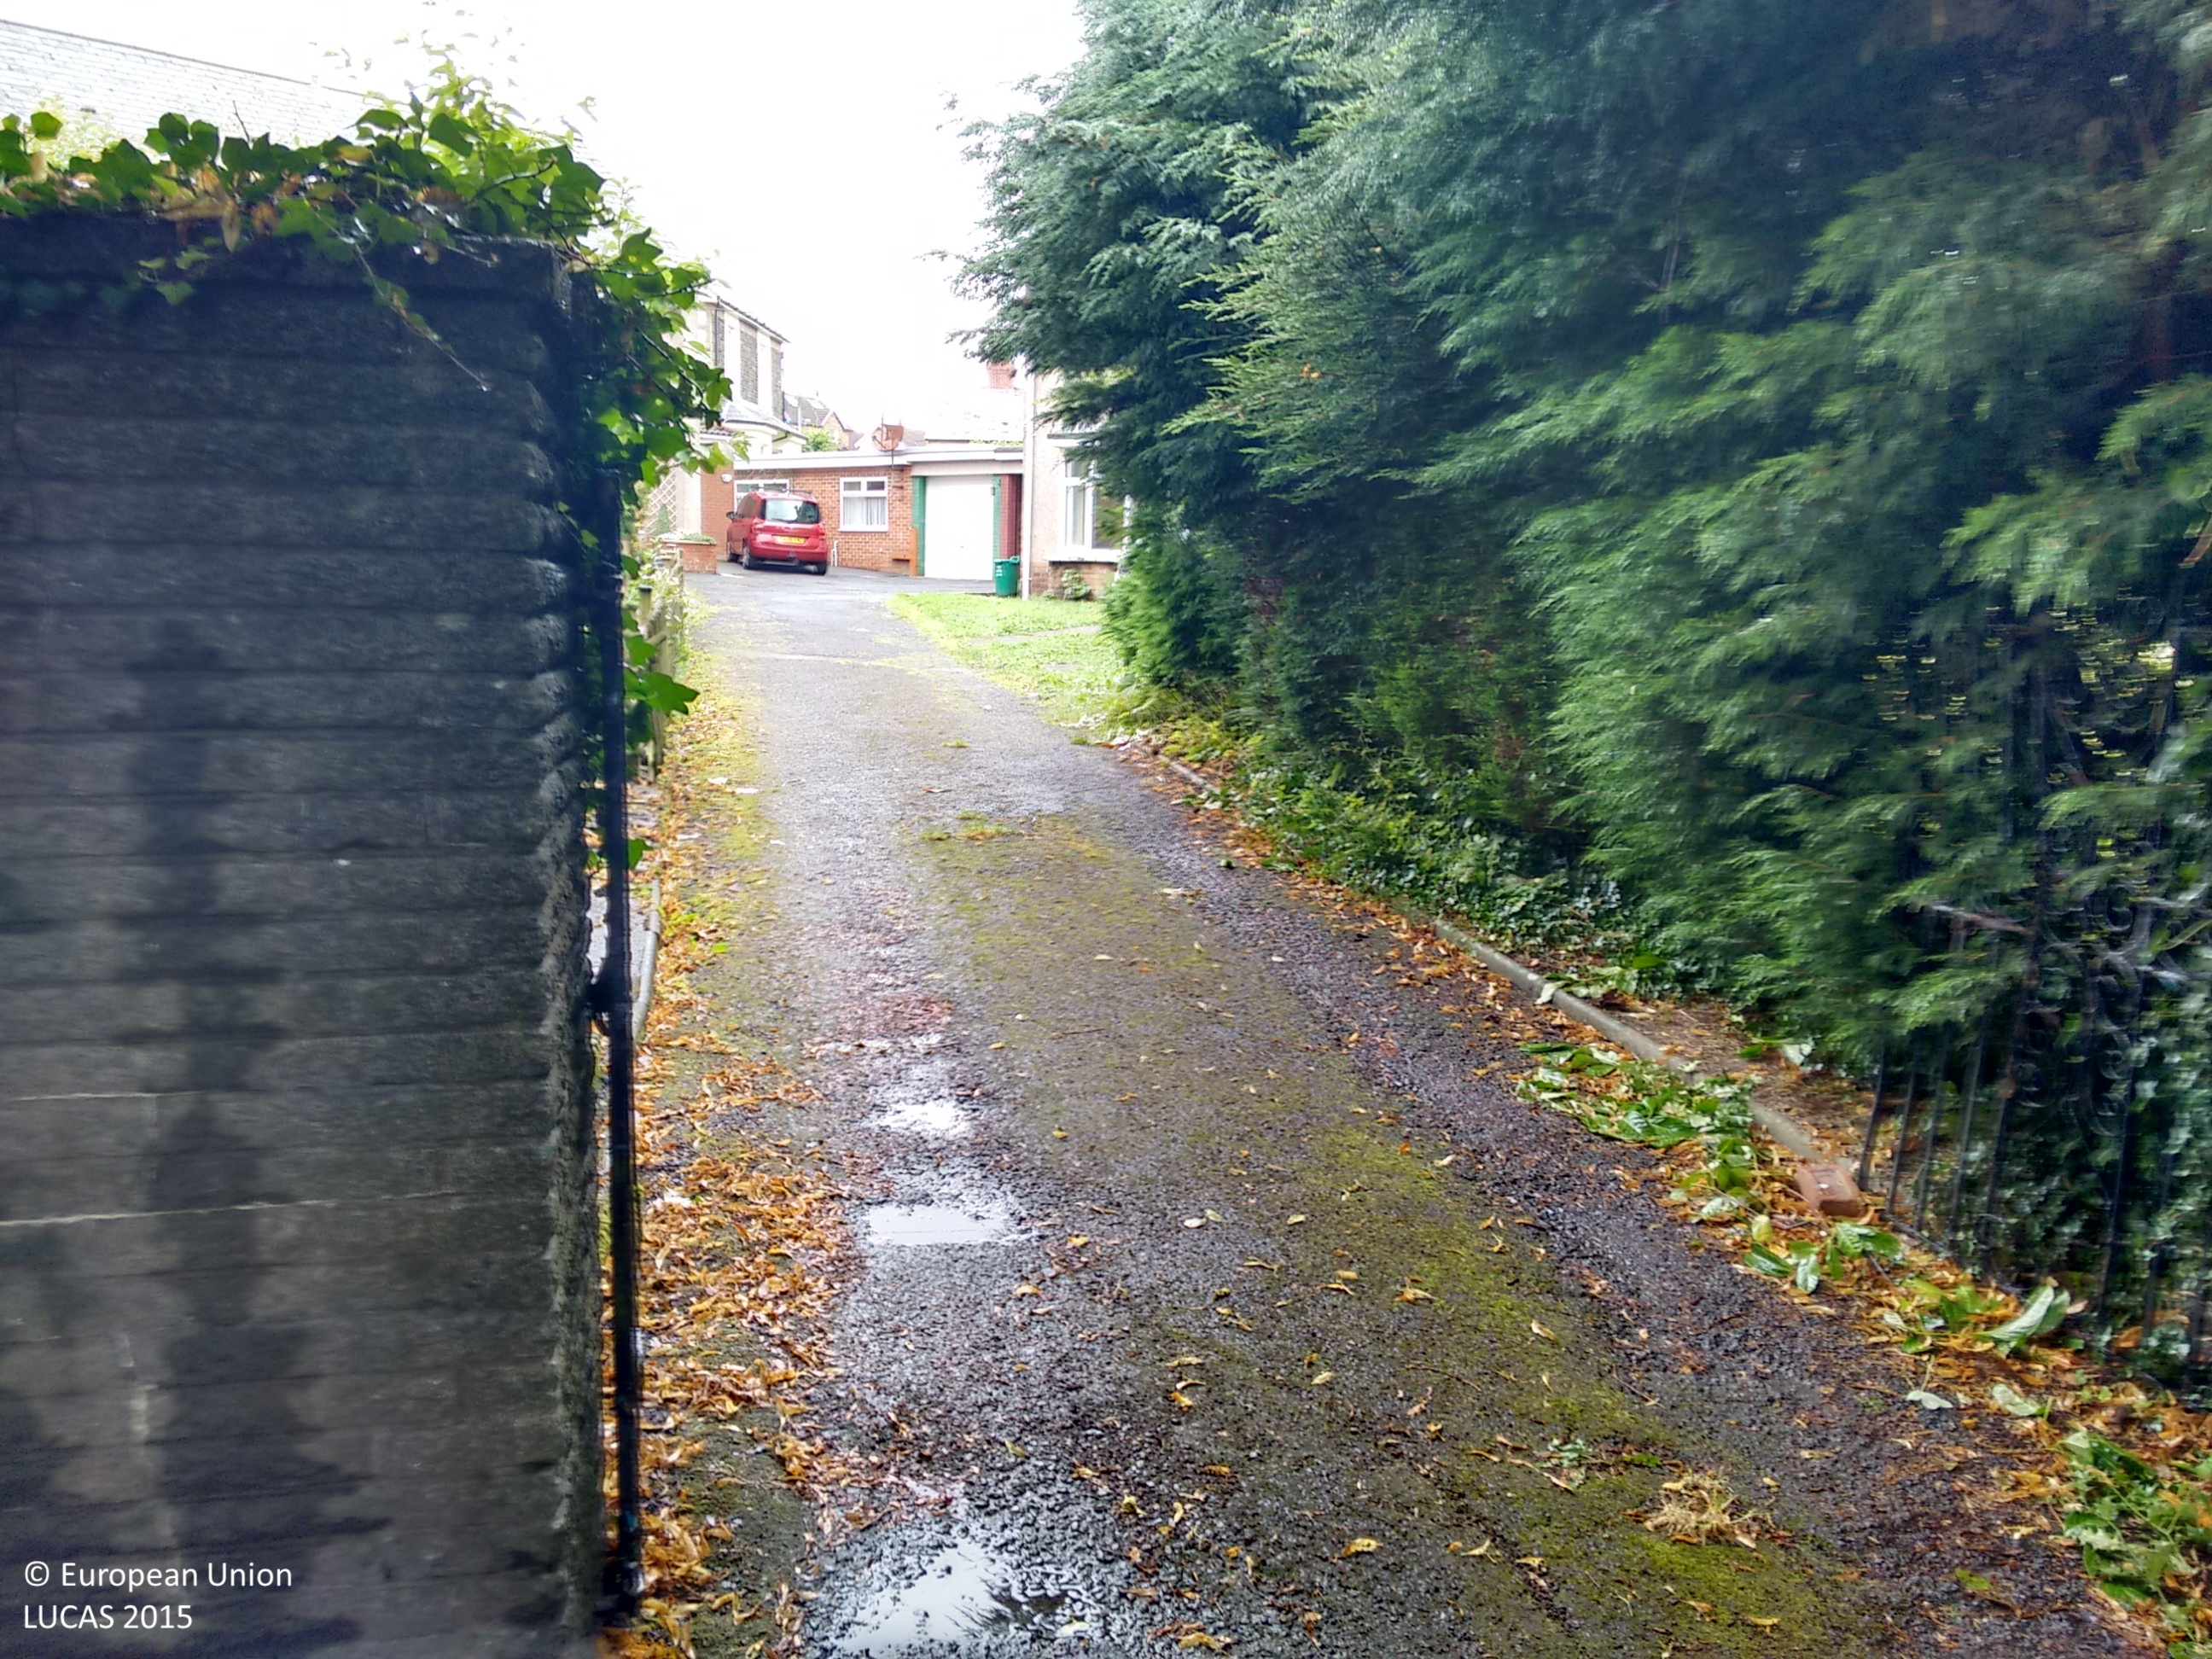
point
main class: Grassland
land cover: Grassland without tree/shrub cover
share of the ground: > 75 %
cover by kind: herbaceous plants 100 %
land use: Residential
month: July
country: GB
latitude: 51.6008
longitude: -3.3496
